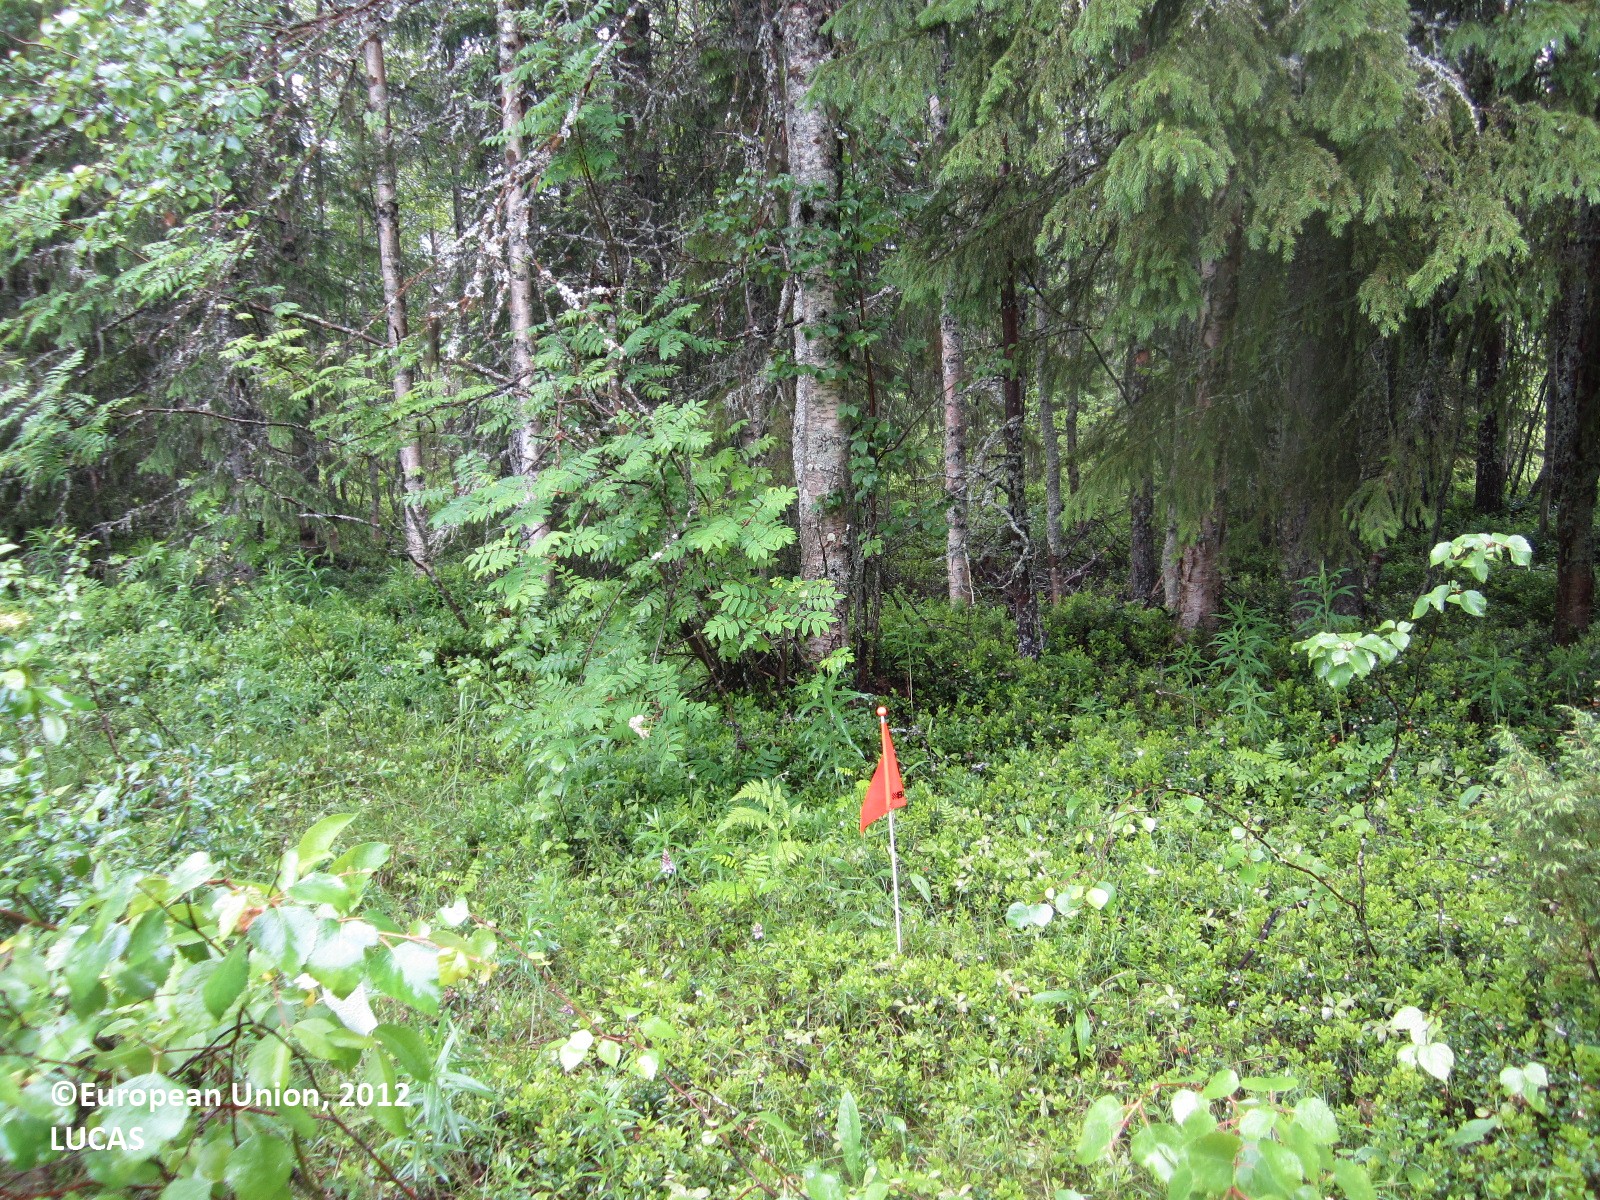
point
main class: Woodland
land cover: Spruce dominated mixed woodland
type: boreal forest
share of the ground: 50 - 75 %
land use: Forestry
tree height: > 5 m
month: June
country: FI
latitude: 64.6120
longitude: 29.9423
